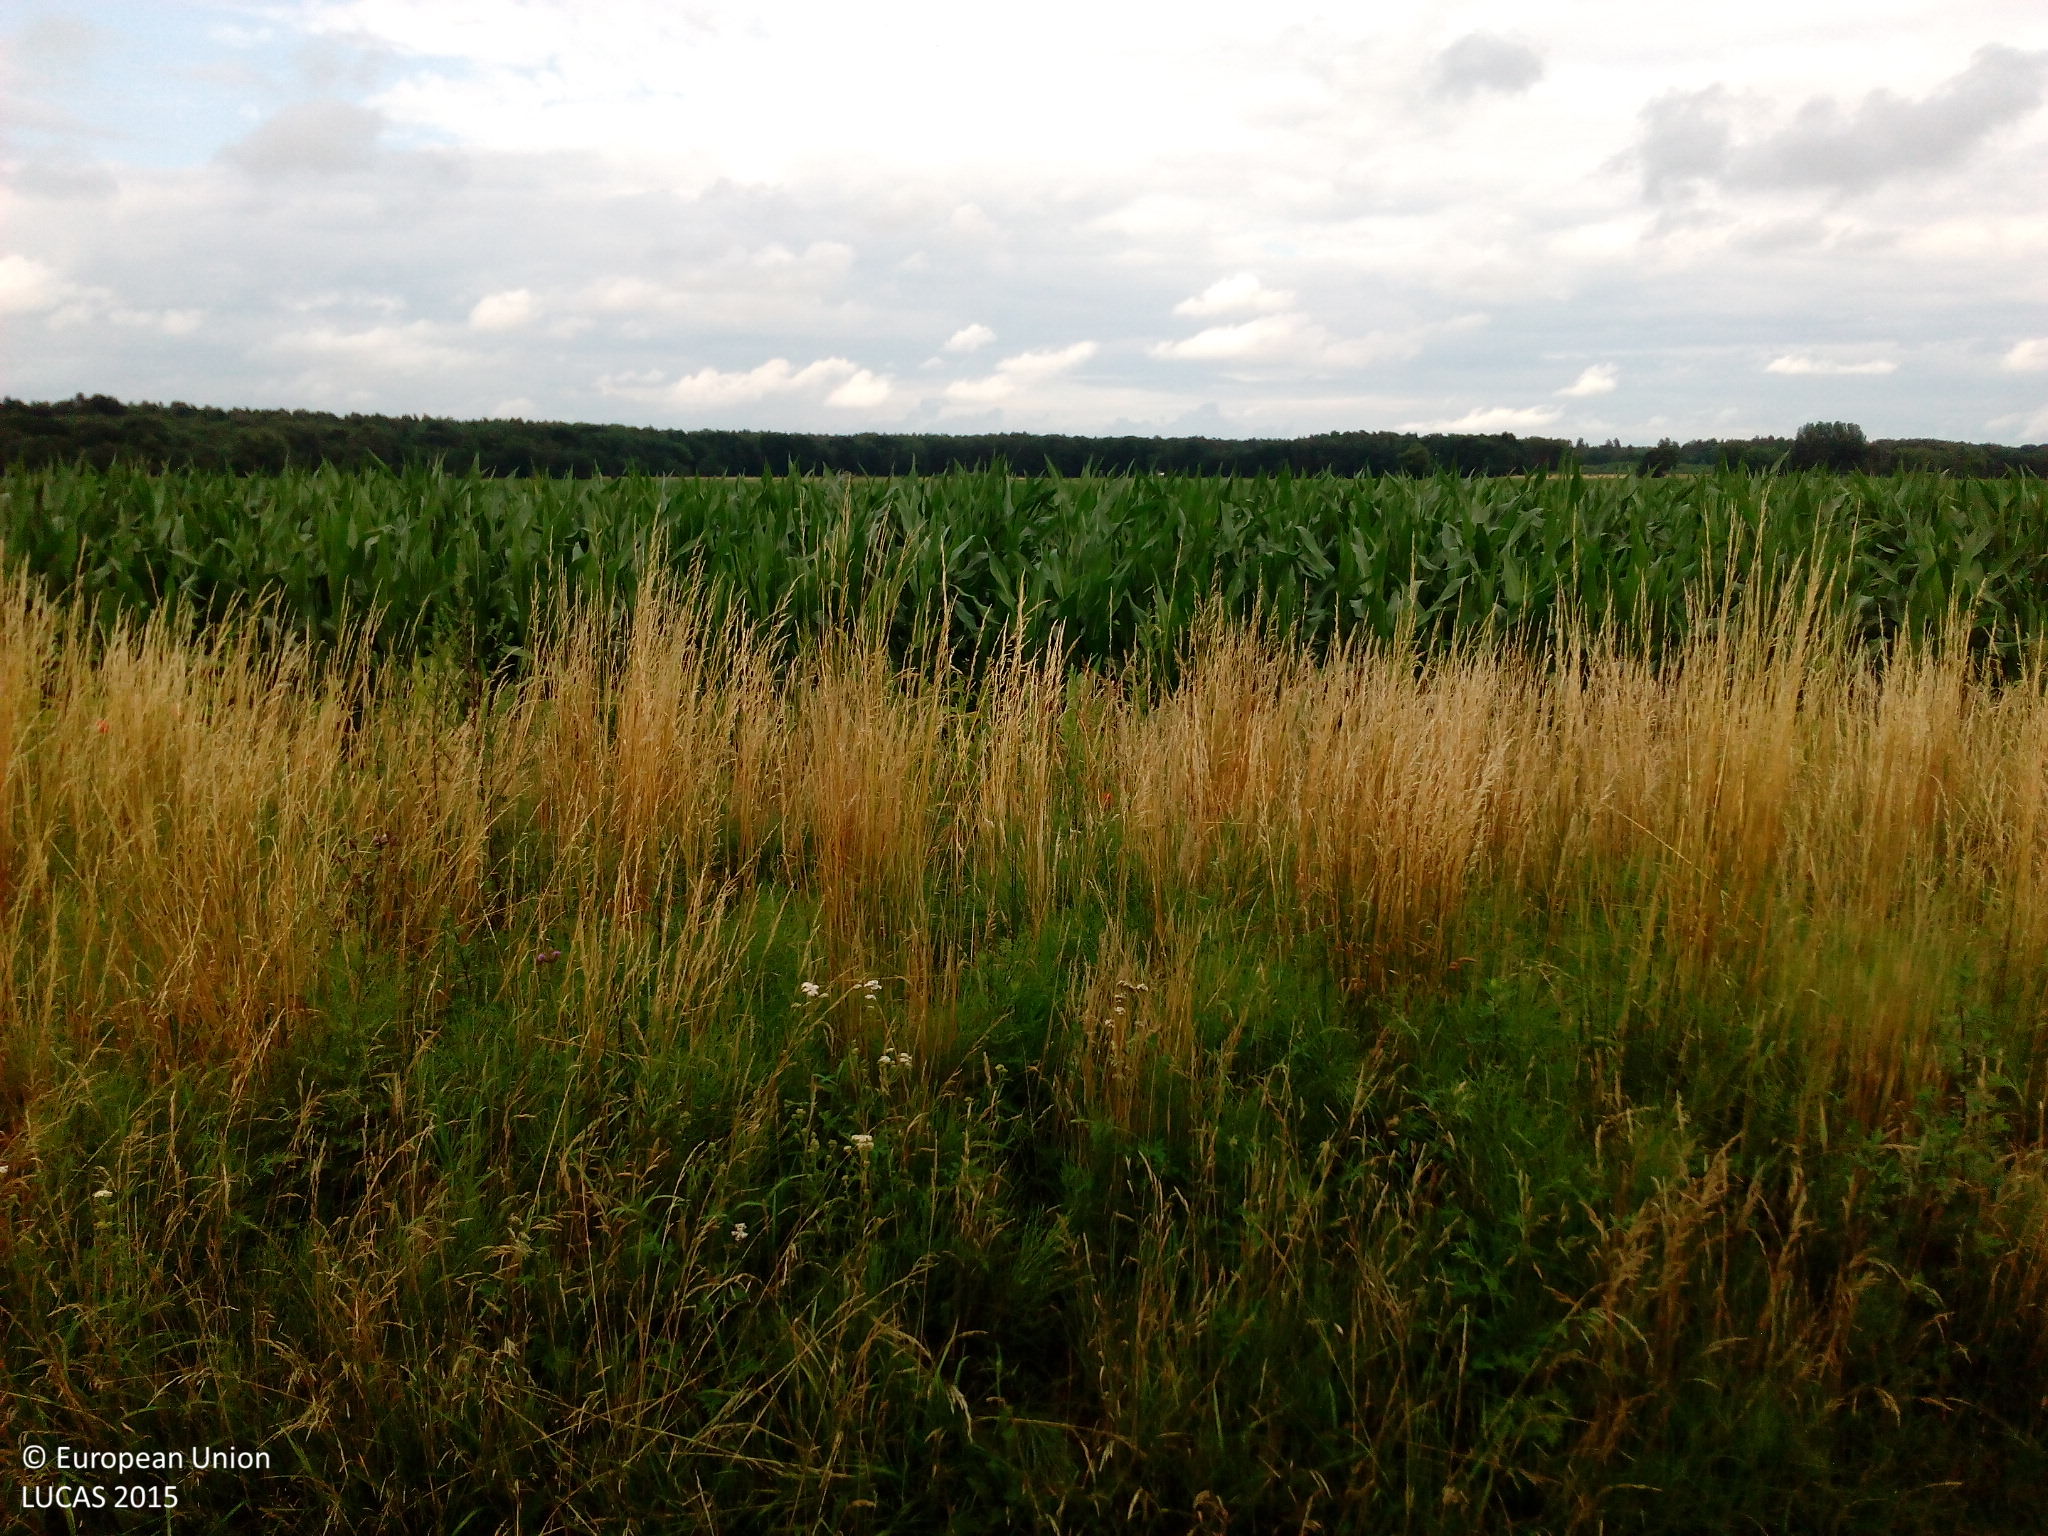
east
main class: Cropland
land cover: Rape and turnip rape
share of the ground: > 75 %
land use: Agriculture (excluding fallow land and kitchen gardens)
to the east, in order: Rape and turnip rape; Tracks; Spontaneously vegetated surfaces; Maize
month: July
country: DE
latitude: 52.7321
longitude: 13.1245
